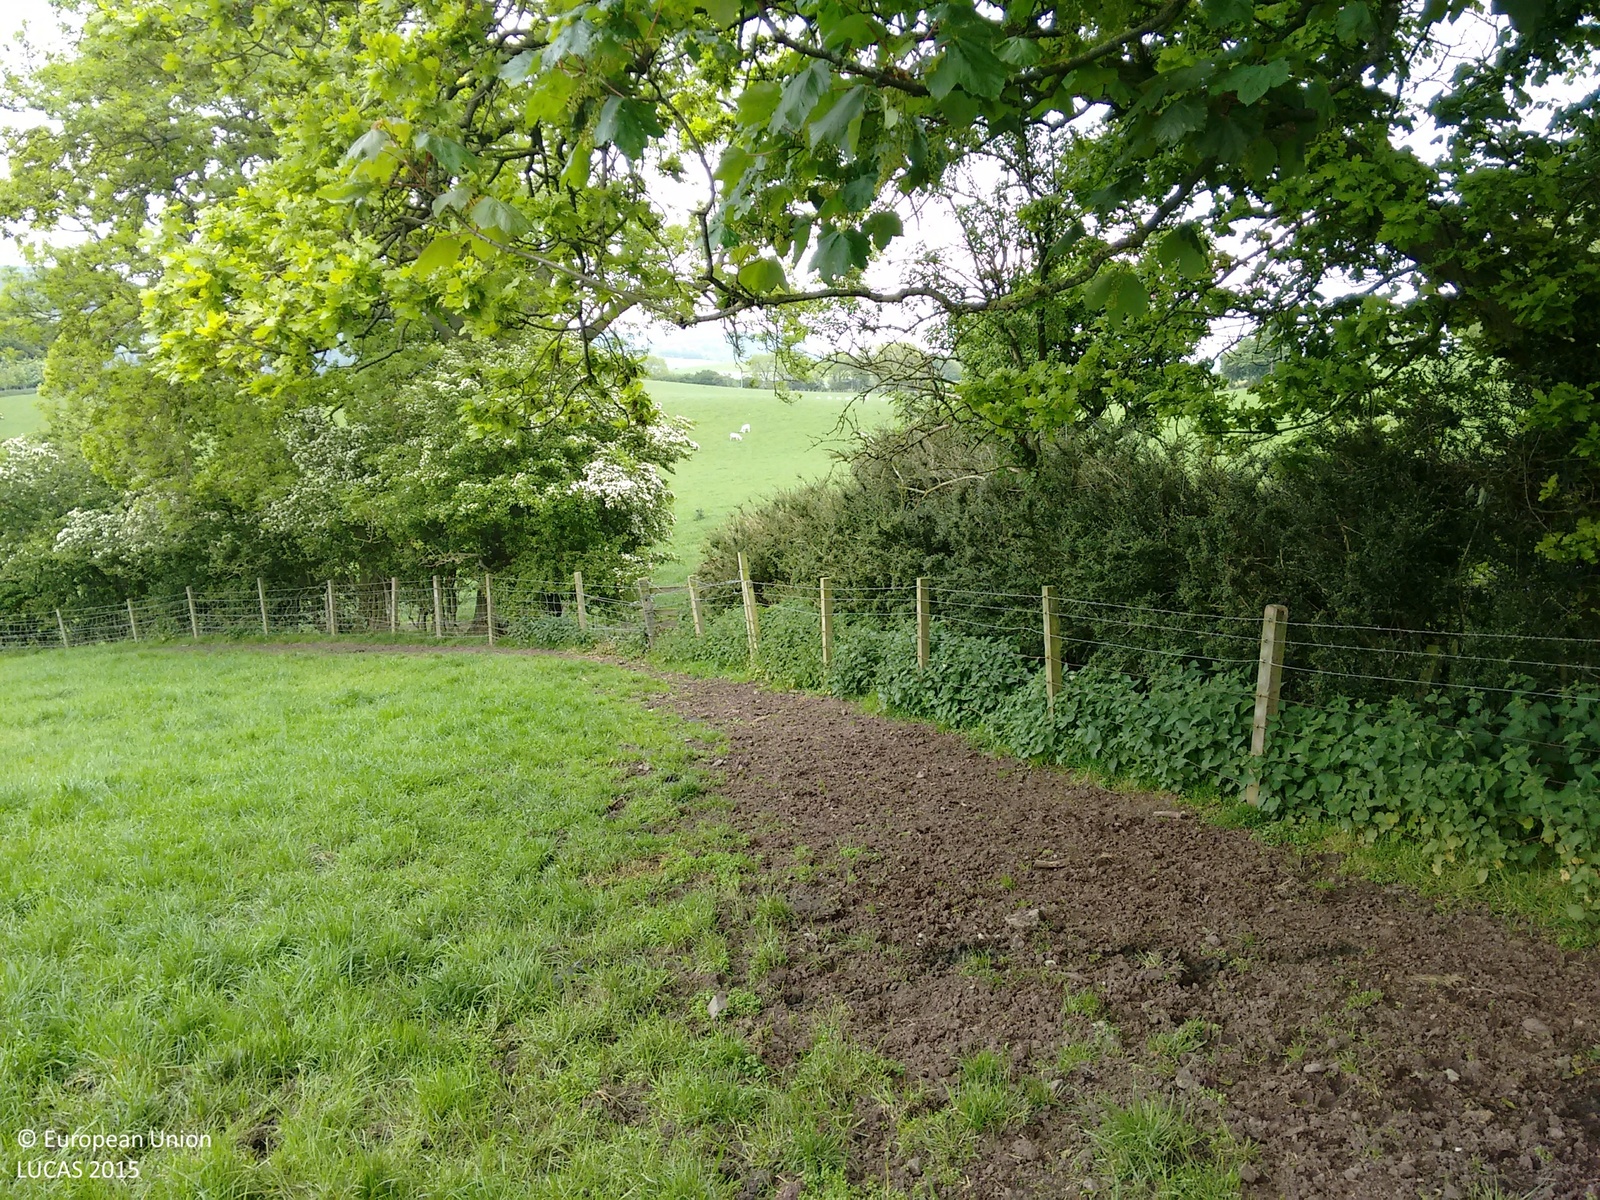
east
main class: Grassland
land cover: Grassland without tree/shrub cover
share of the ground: > 75 %
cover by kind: herbaceous plants 90 %, unconsolidated bare surface 10 %
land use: Agriculture (excluding fallow land and kitchen gardens)
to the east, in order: Grassland without tree/shrub cover; Fences; Dry stone walls
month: June
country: GB
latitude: 56.3753
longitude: -3.3999
